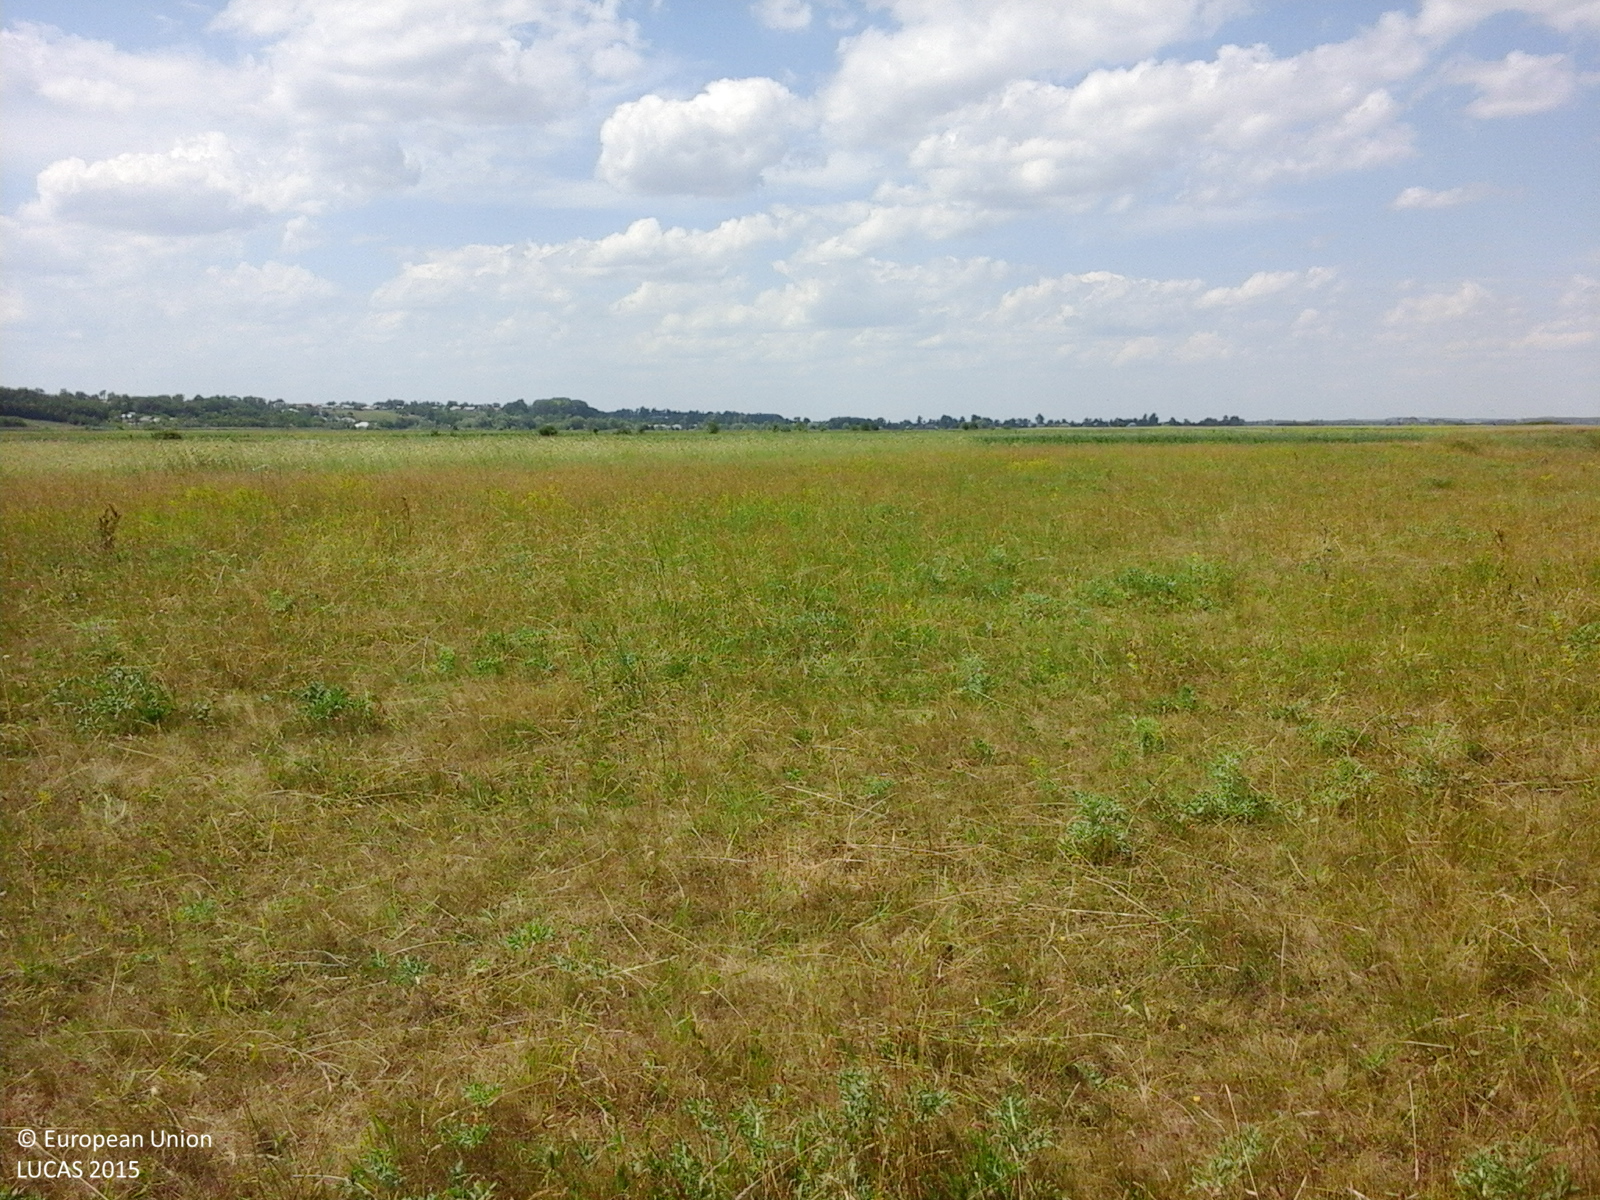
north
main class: Grassland
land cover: Grassland without tree/shrub cover
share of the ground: > 75 %
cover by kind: herbaceous plants 100 %
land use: Agriculture (excluding fallow land and kitchen gardens)
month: June
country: RO
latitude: 47.5871
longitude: 26.5391
